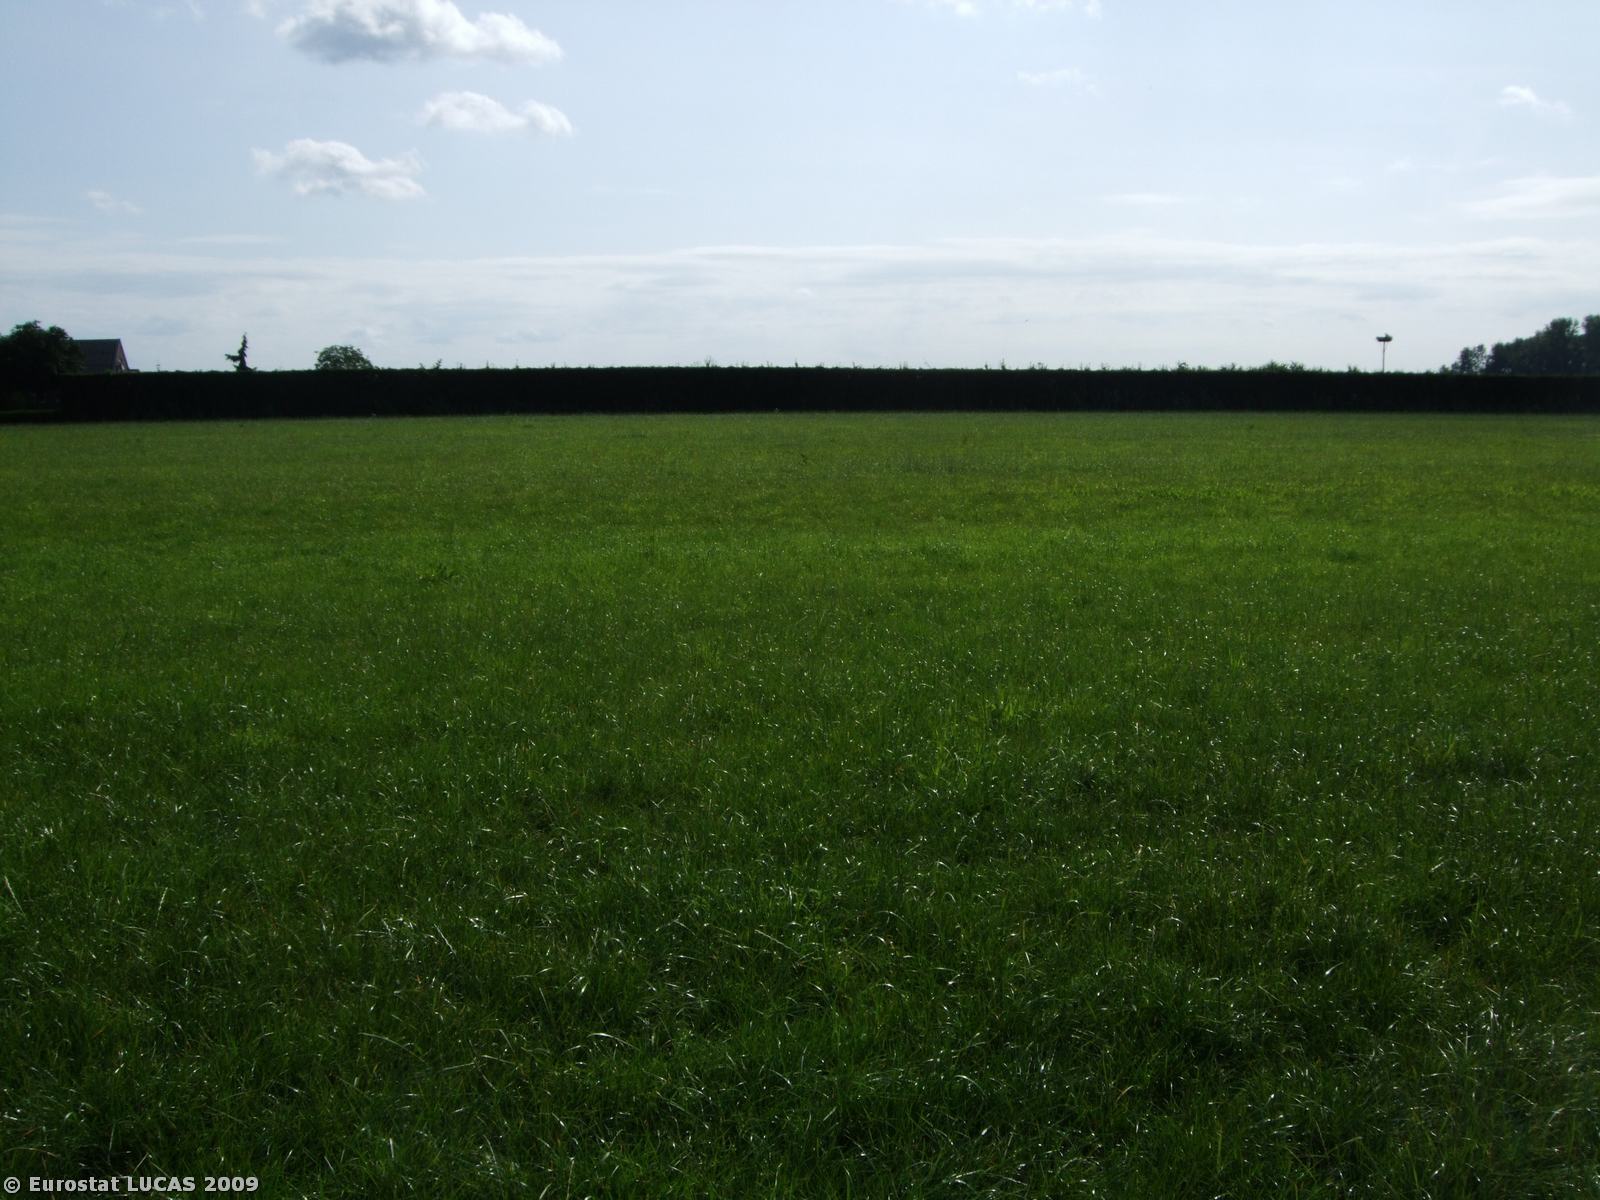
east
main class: Grassland
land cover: Grassland without tree/shrub cover
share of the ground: > 75 %
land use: Agriculture (excluding fallow land and kitchen gardens)
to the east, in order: Grassland without tree/shrub cover; Ditches and canals; Conifer hedges; Apple fruit; Grass margins; Fences; Ditches and canals; Grassland without tree/shrub cover
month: July
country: NL
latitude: 51.9458
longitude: 5.3863
